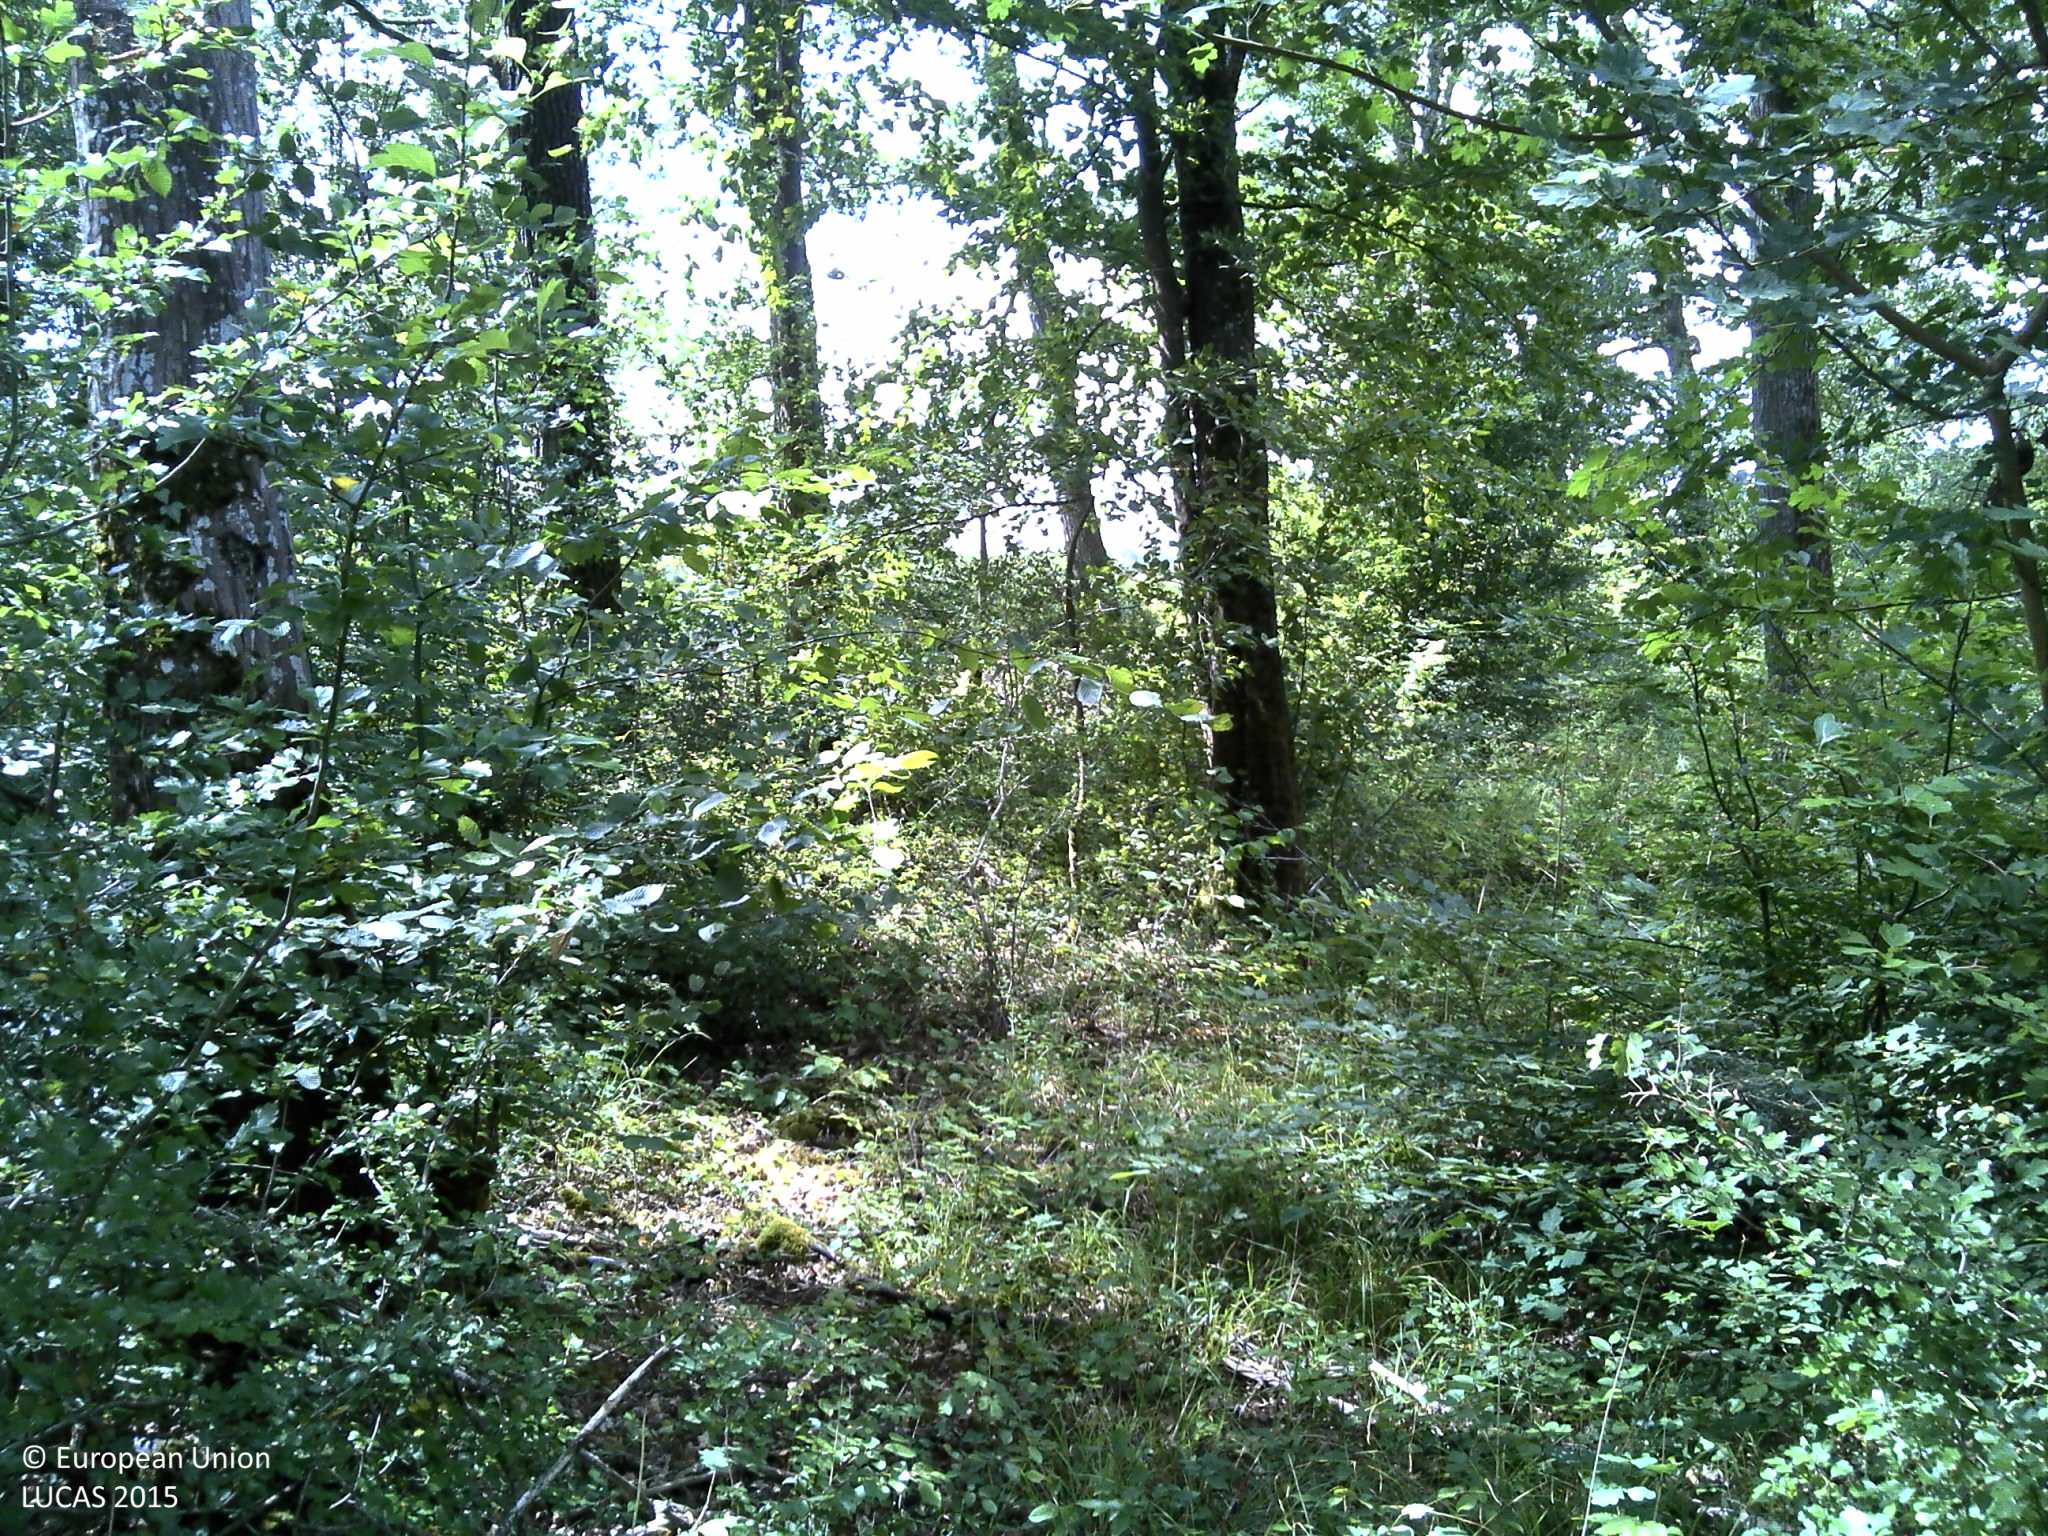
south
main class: Woodland
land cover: Broadleaved woodland
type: beech forest
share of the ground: > 75 %
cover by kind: broadleaved forest trees 85 %, herbaceous plants 10 %, coniferous forest trees 5 %
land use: Forestry
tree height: > 5 m
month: July
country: FR
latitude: 48.8007
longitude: 4.7286
